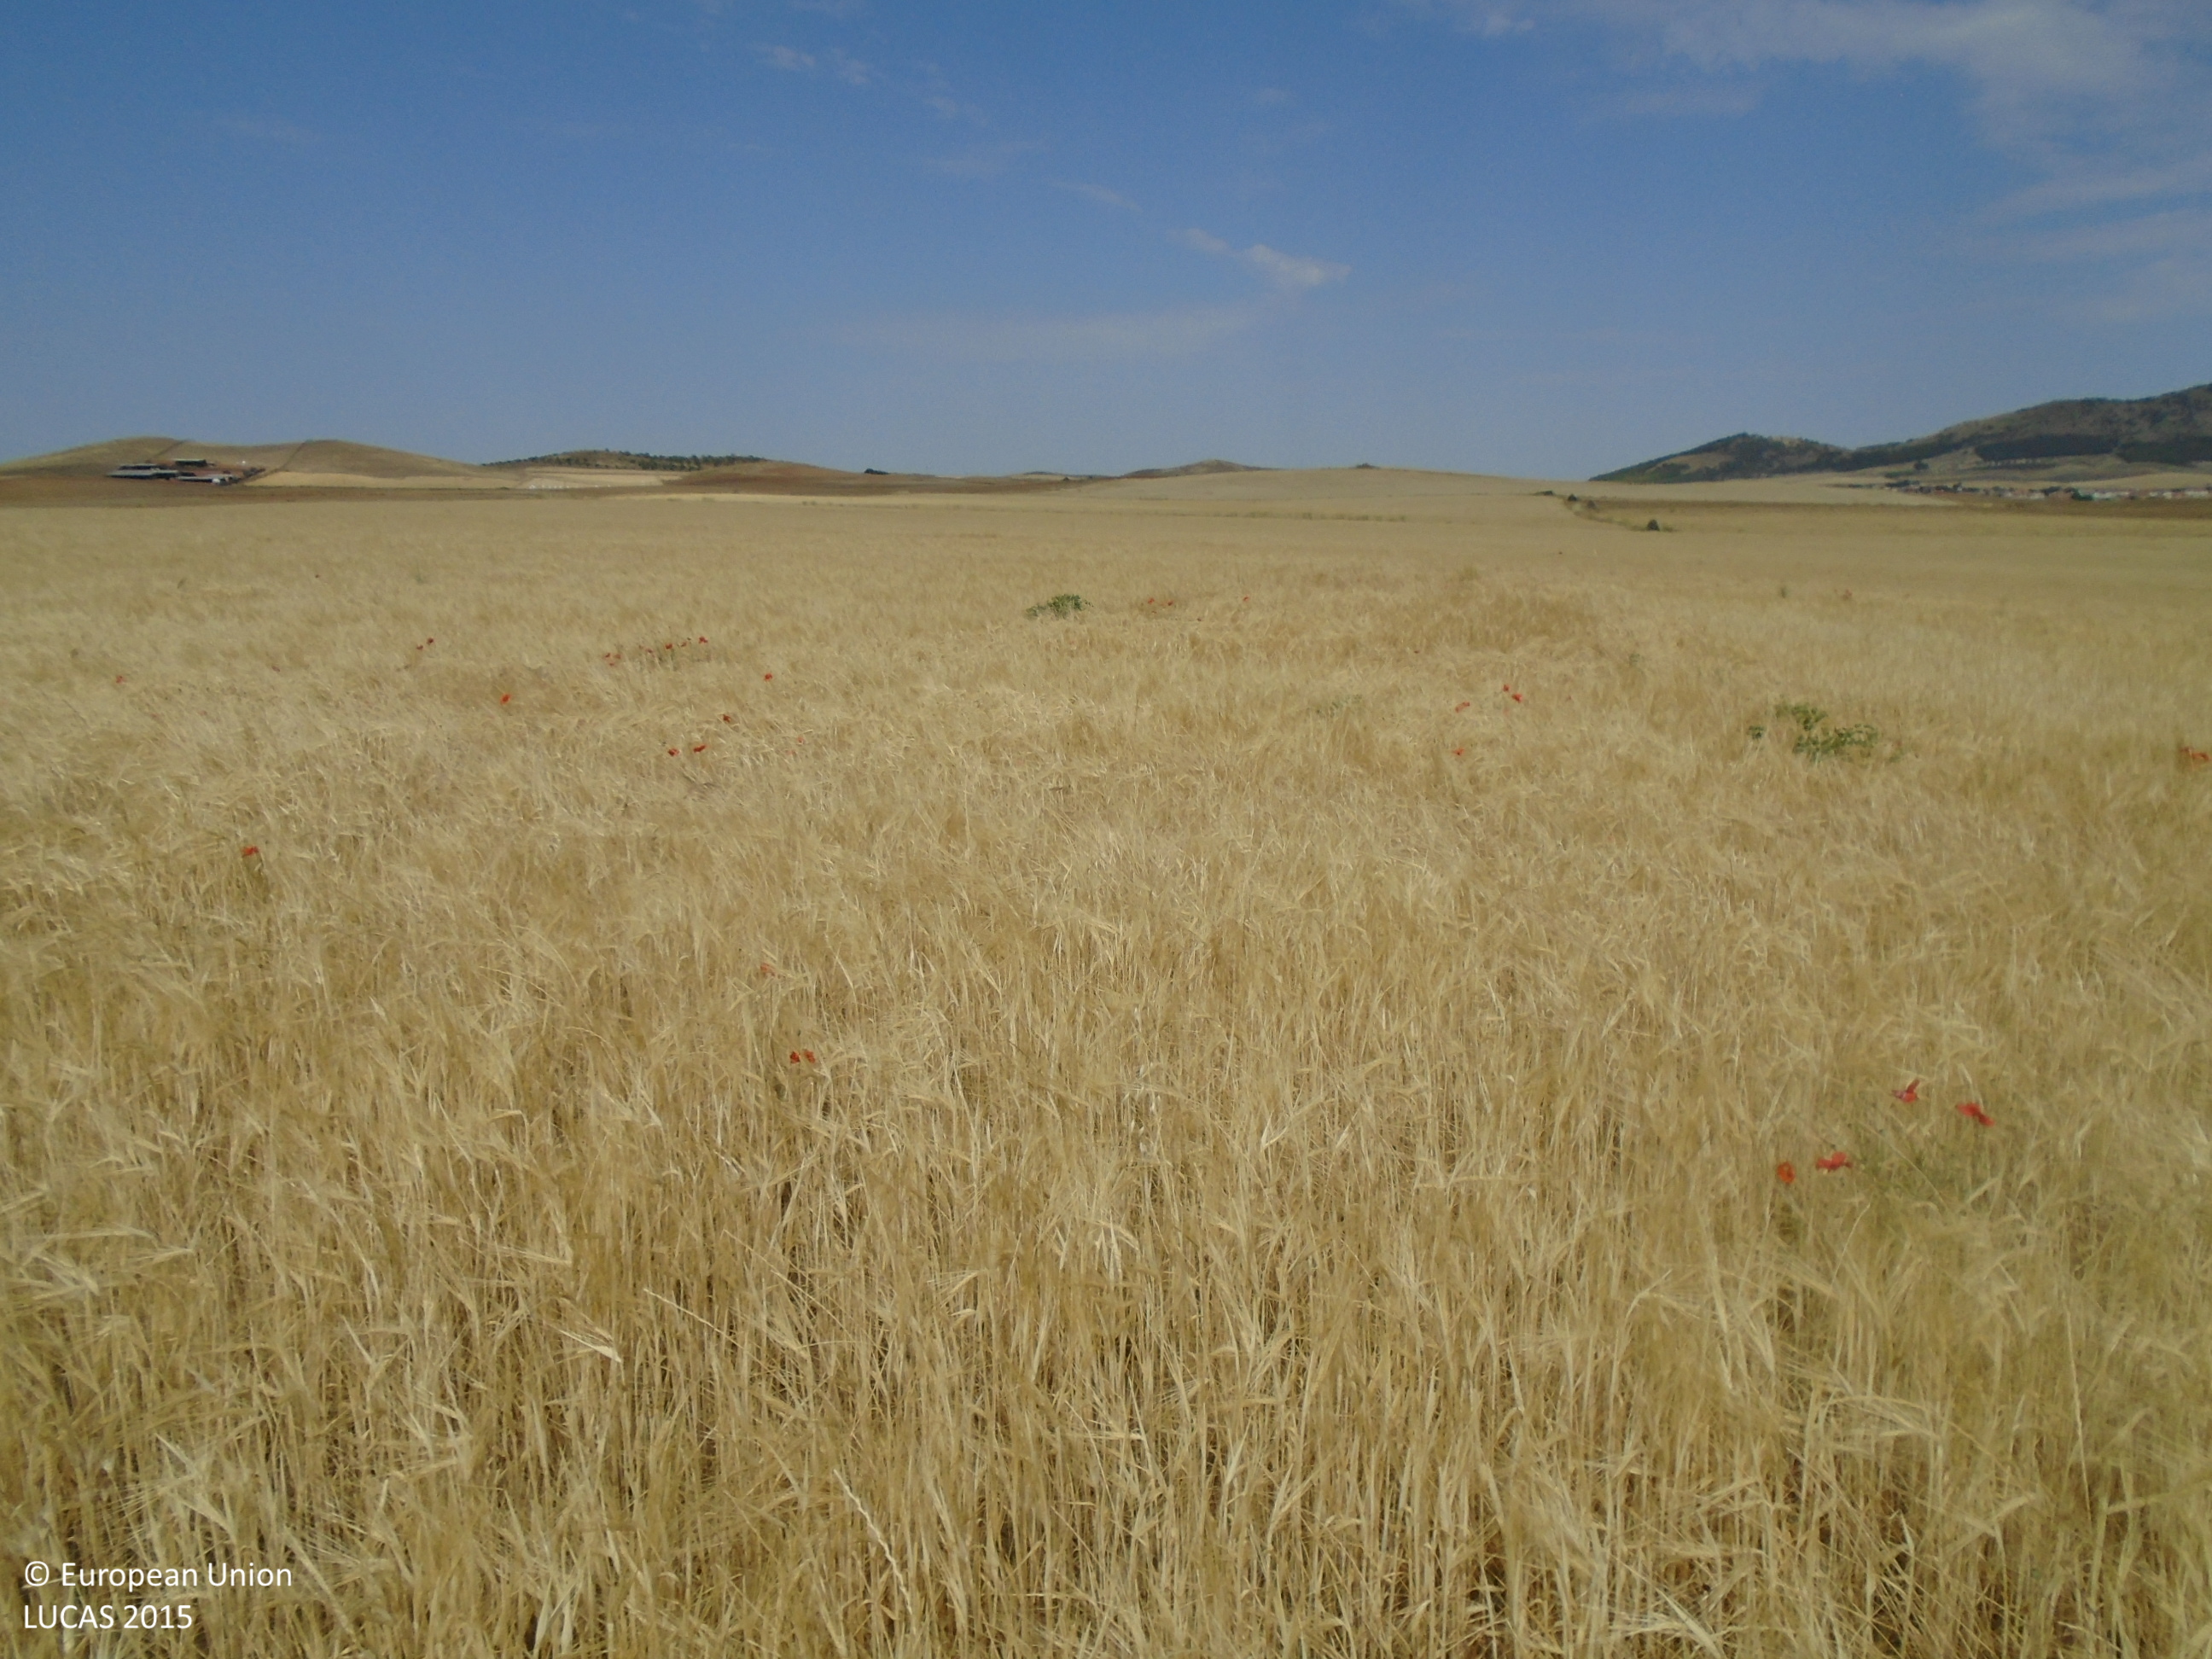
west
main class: Cropland
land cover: Barley
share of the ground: > 75 %
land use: Agriculture (excluding fallow land and kitchen gardens)
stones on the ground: < 10 %
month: June
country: ES
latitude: 39.7292
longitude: -4.1636
